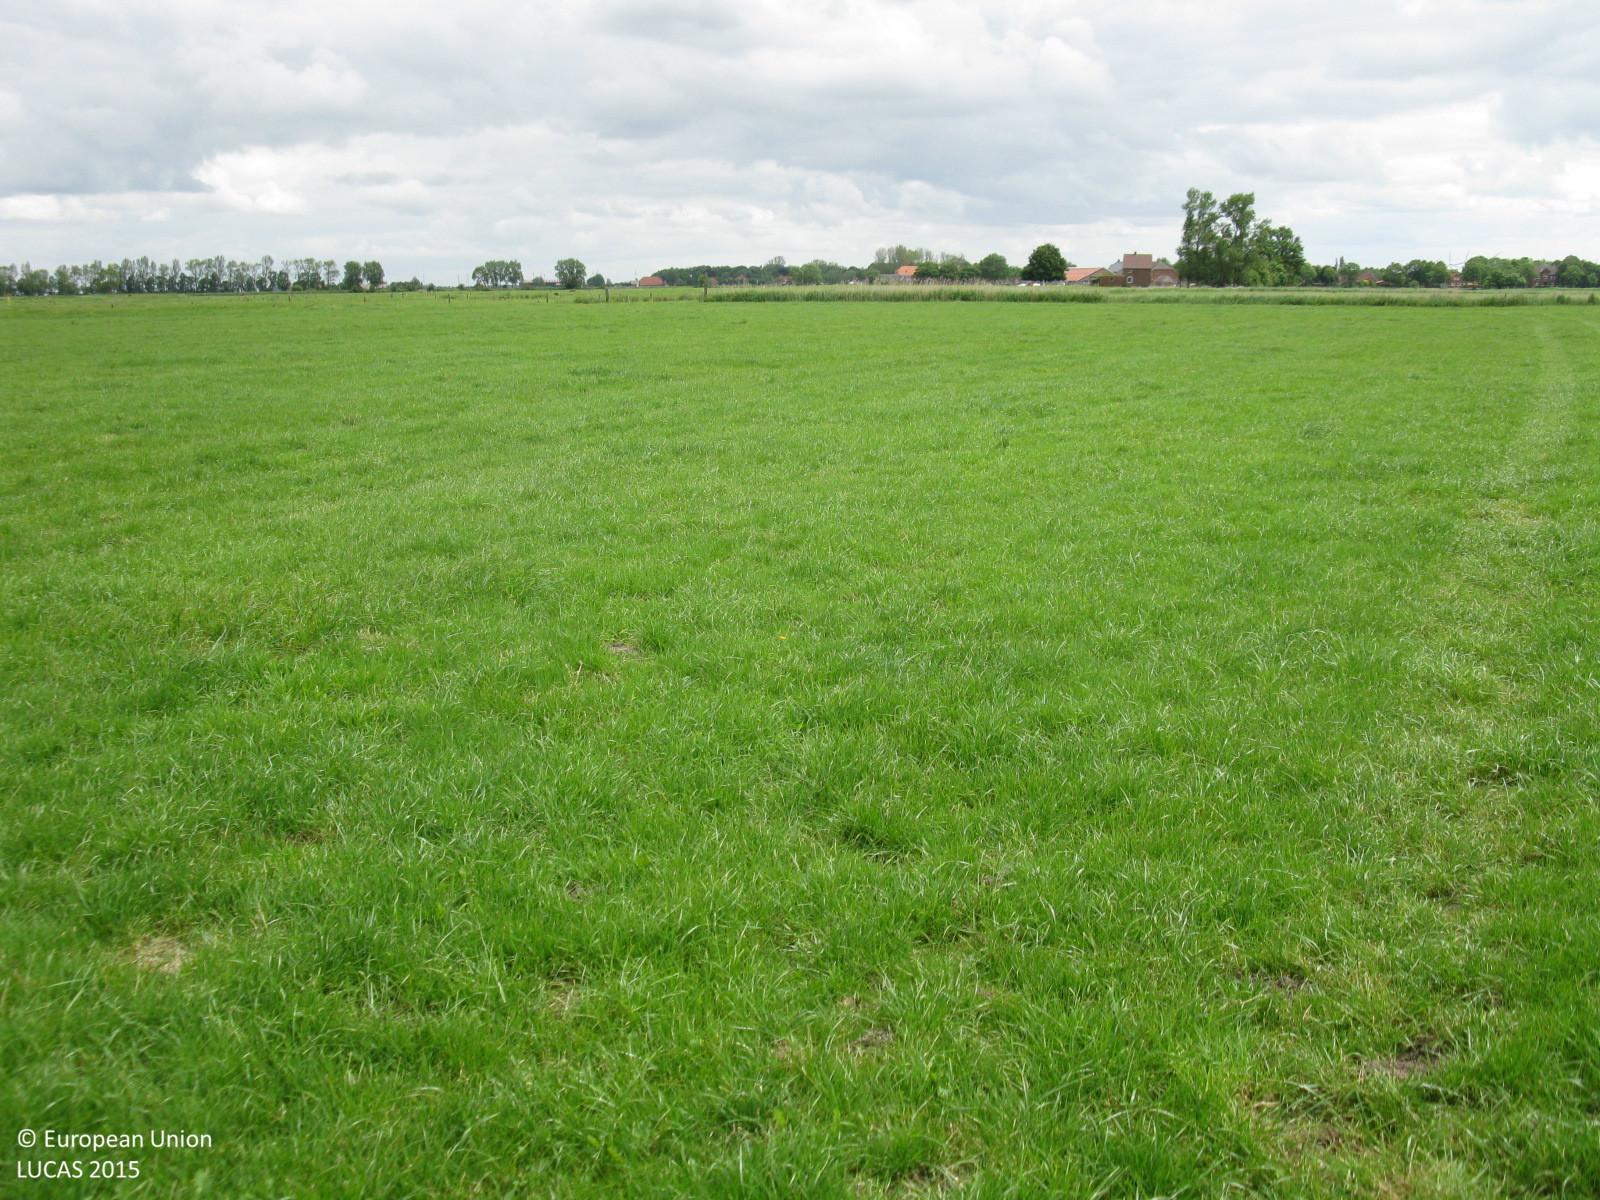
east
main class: Grassland
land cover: Grassland without tree/shrub cover
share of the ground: > 75 %
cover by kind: herbaceous plants 100 %
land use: Agriculture (excluding fallow land and kitchen gardens)
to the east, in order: Grassland without tree/shrub cover; Fences; Ditches and canals; Fences; Grassland without tree/shrub cover; Fences; Grassland without tree/shrub cover; Fences; Grassland without tree/shrub cover; Fences; Ditches and canals; Grassland without tree/shrub cover
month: June
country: DE
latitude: 53.3368
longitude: 7.3424
